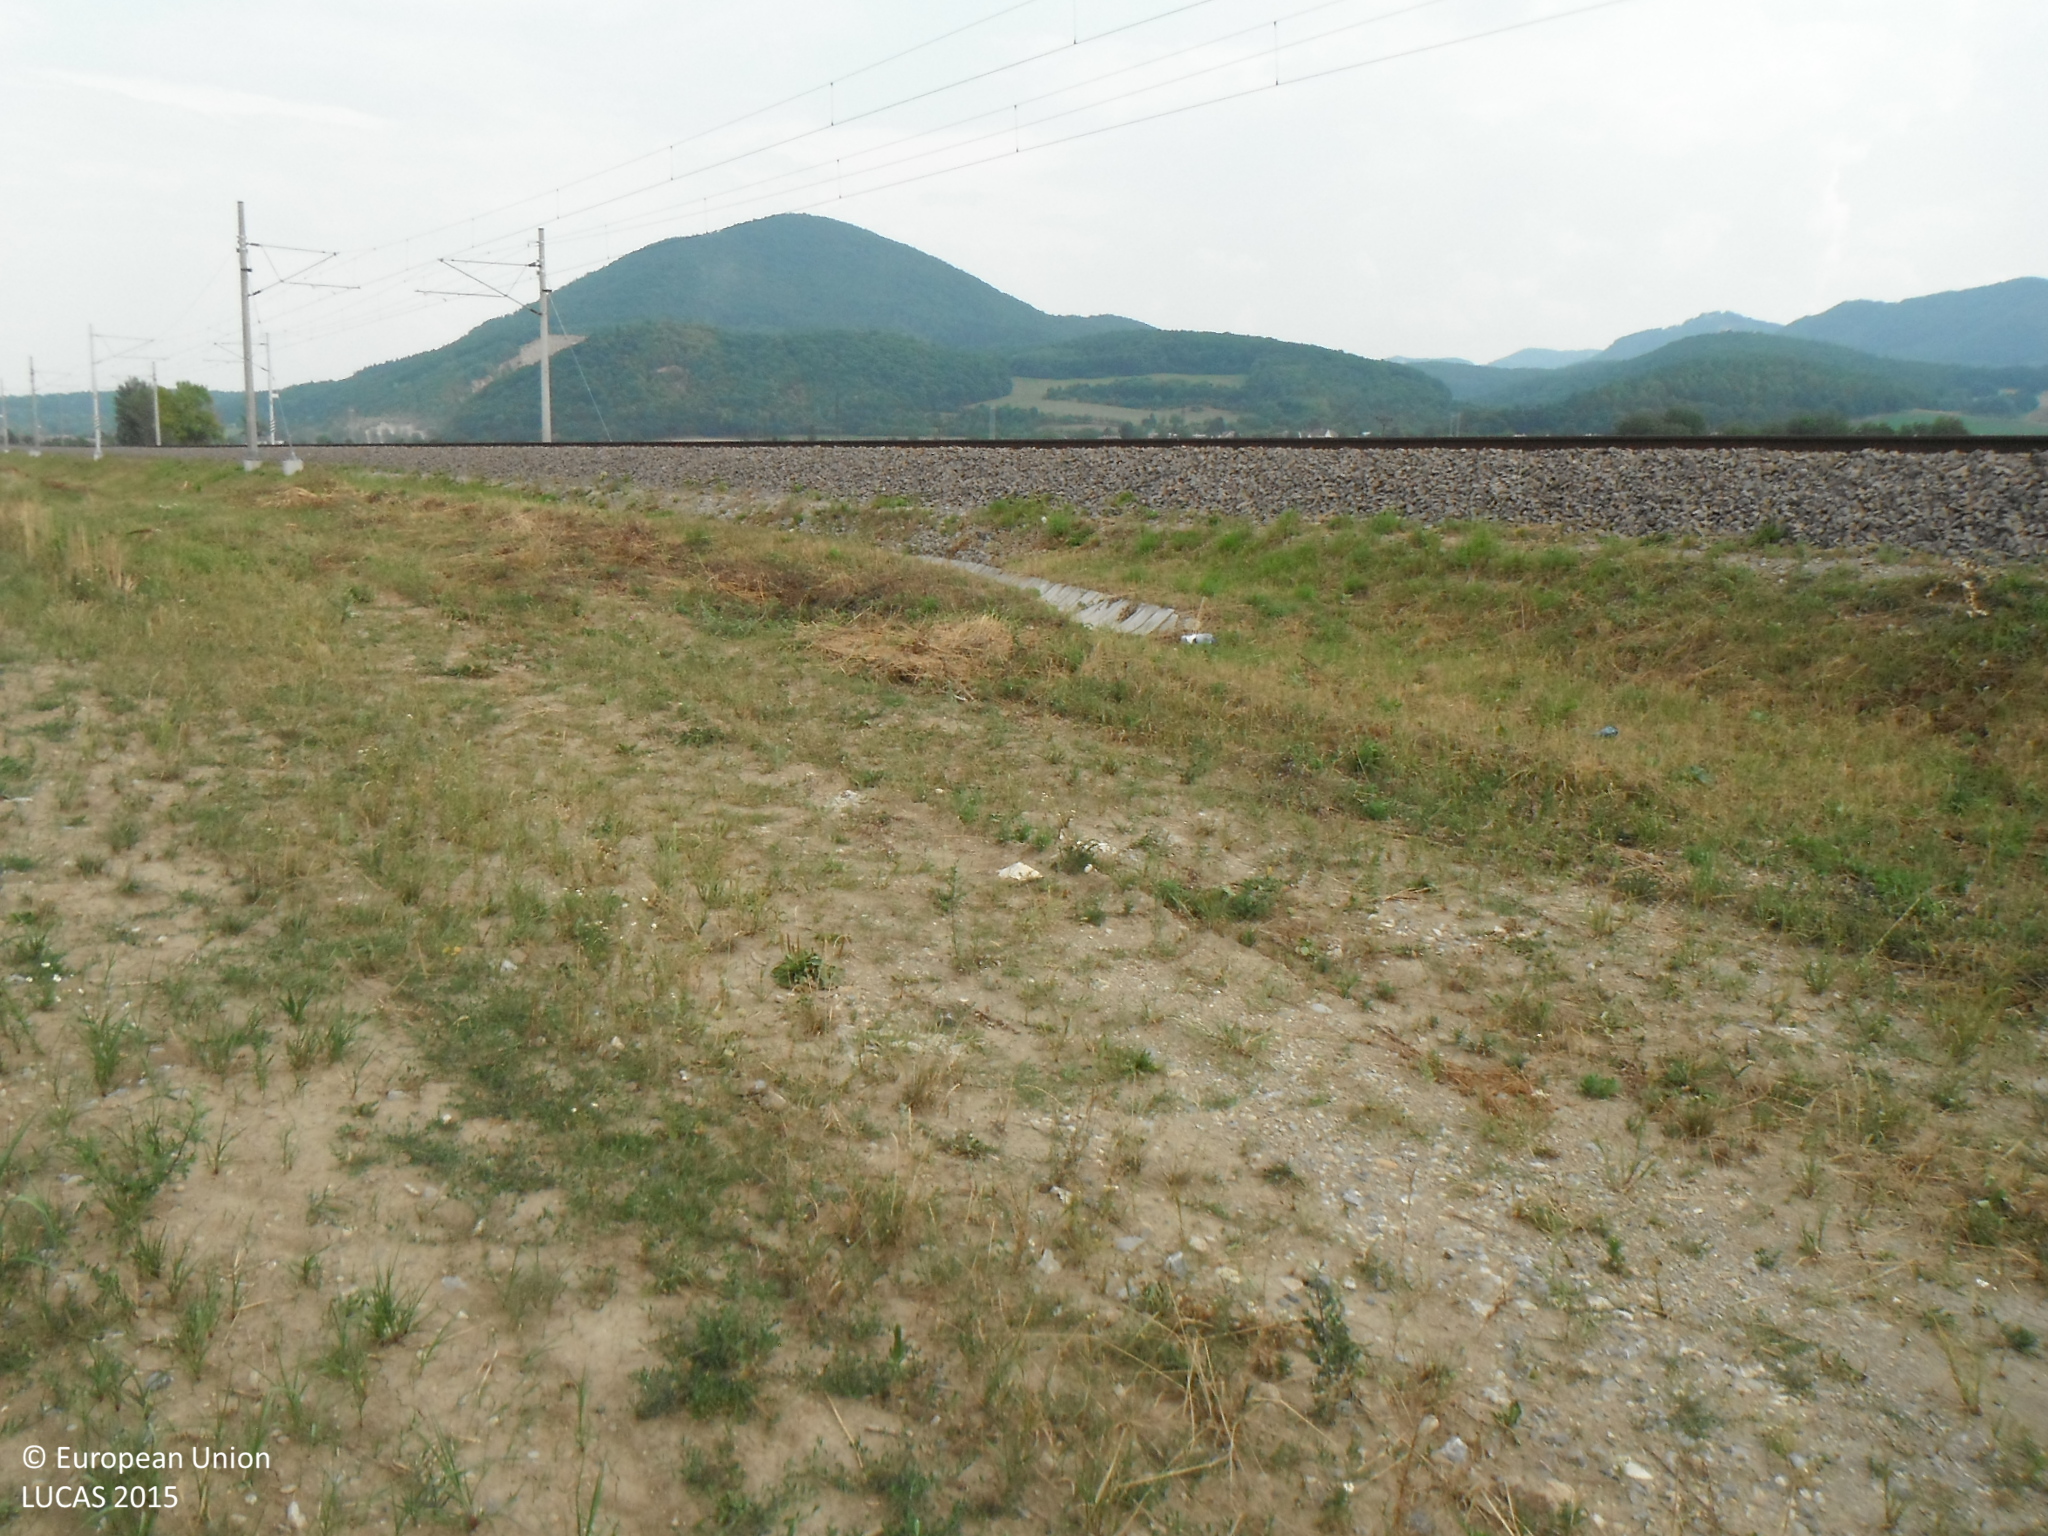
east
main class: Cropland
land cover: Maize
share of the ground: < 10 %
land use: Agriculture (excluding fallow land and kitchen gardens)
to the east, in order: Maize; Spontaneously vegetated surfaces; Railways; Grassland without tree/shrub cover; Spontaneously vegetated surfaces; Ditches and canals; Grass margins; Maize
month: August
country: SK
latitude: 49.0163
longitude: 18.2611
